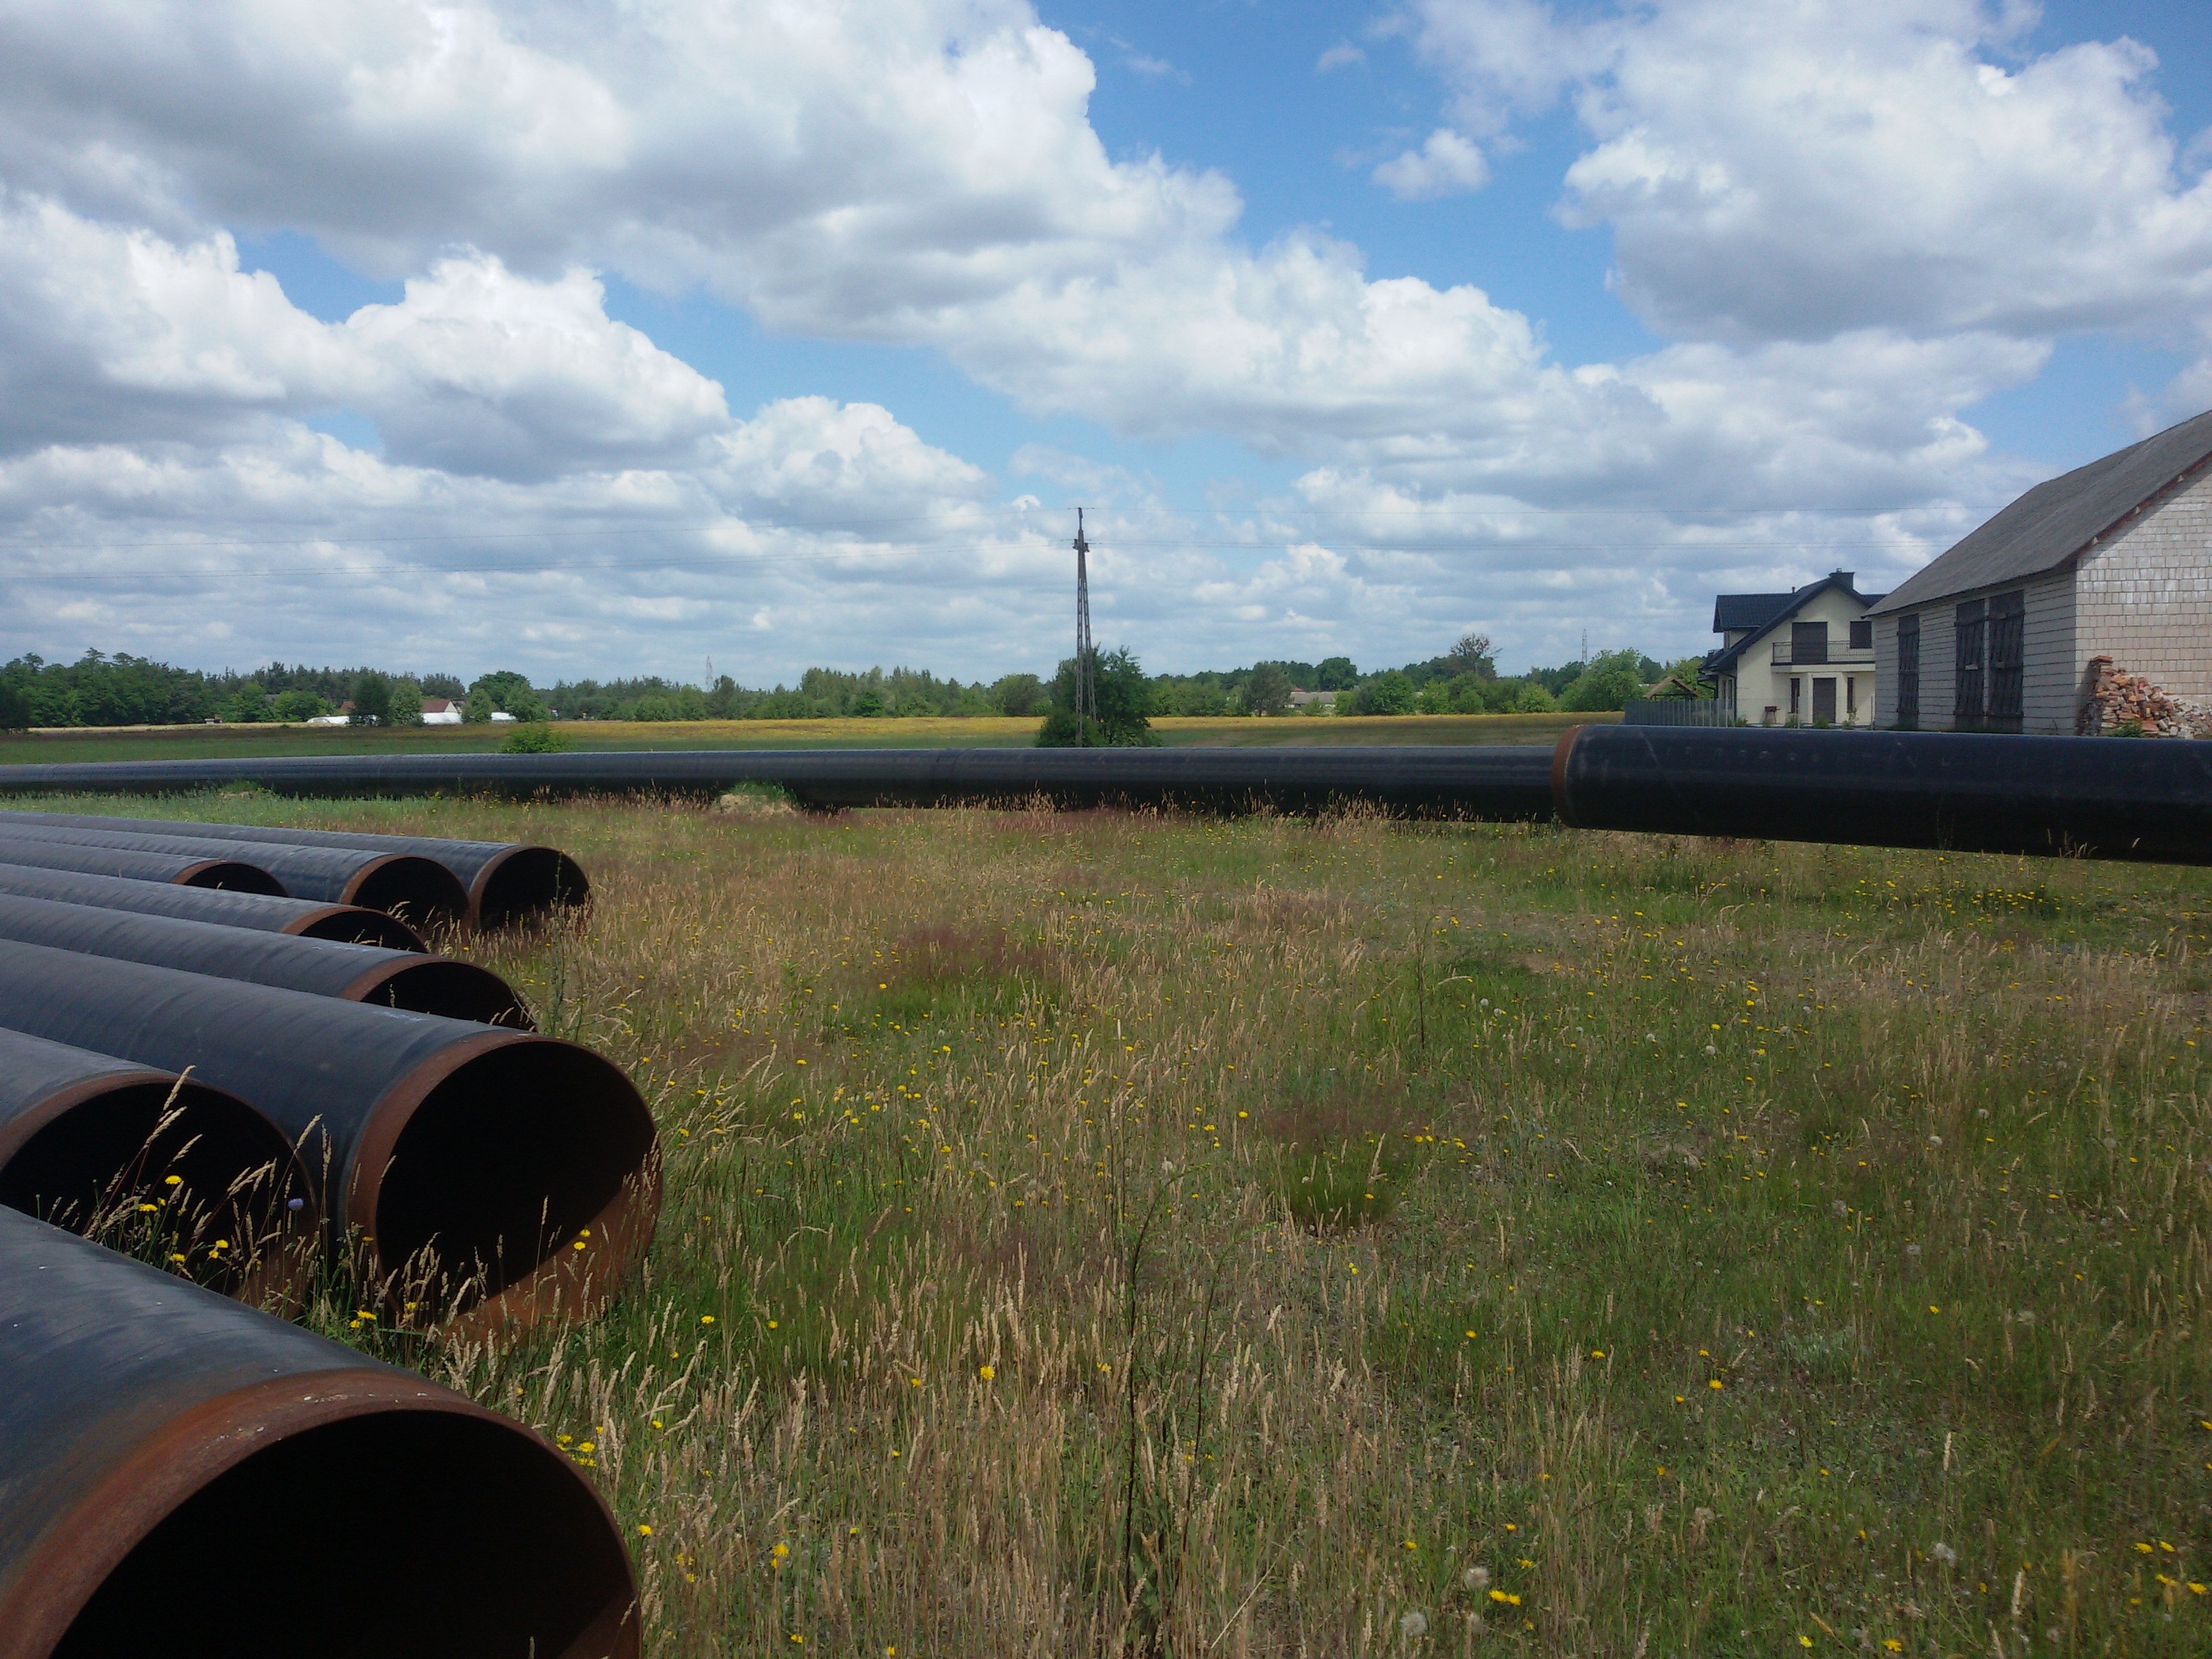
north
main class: Grassland
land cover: Grassland without tree/shrub cover
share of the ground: > 75 %
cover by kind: herbaceous plants 100 %
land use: Agriculture (excluding fallow land and kitchen gardens)
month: June
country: PL
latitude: 52.4557
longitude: 20.8885
